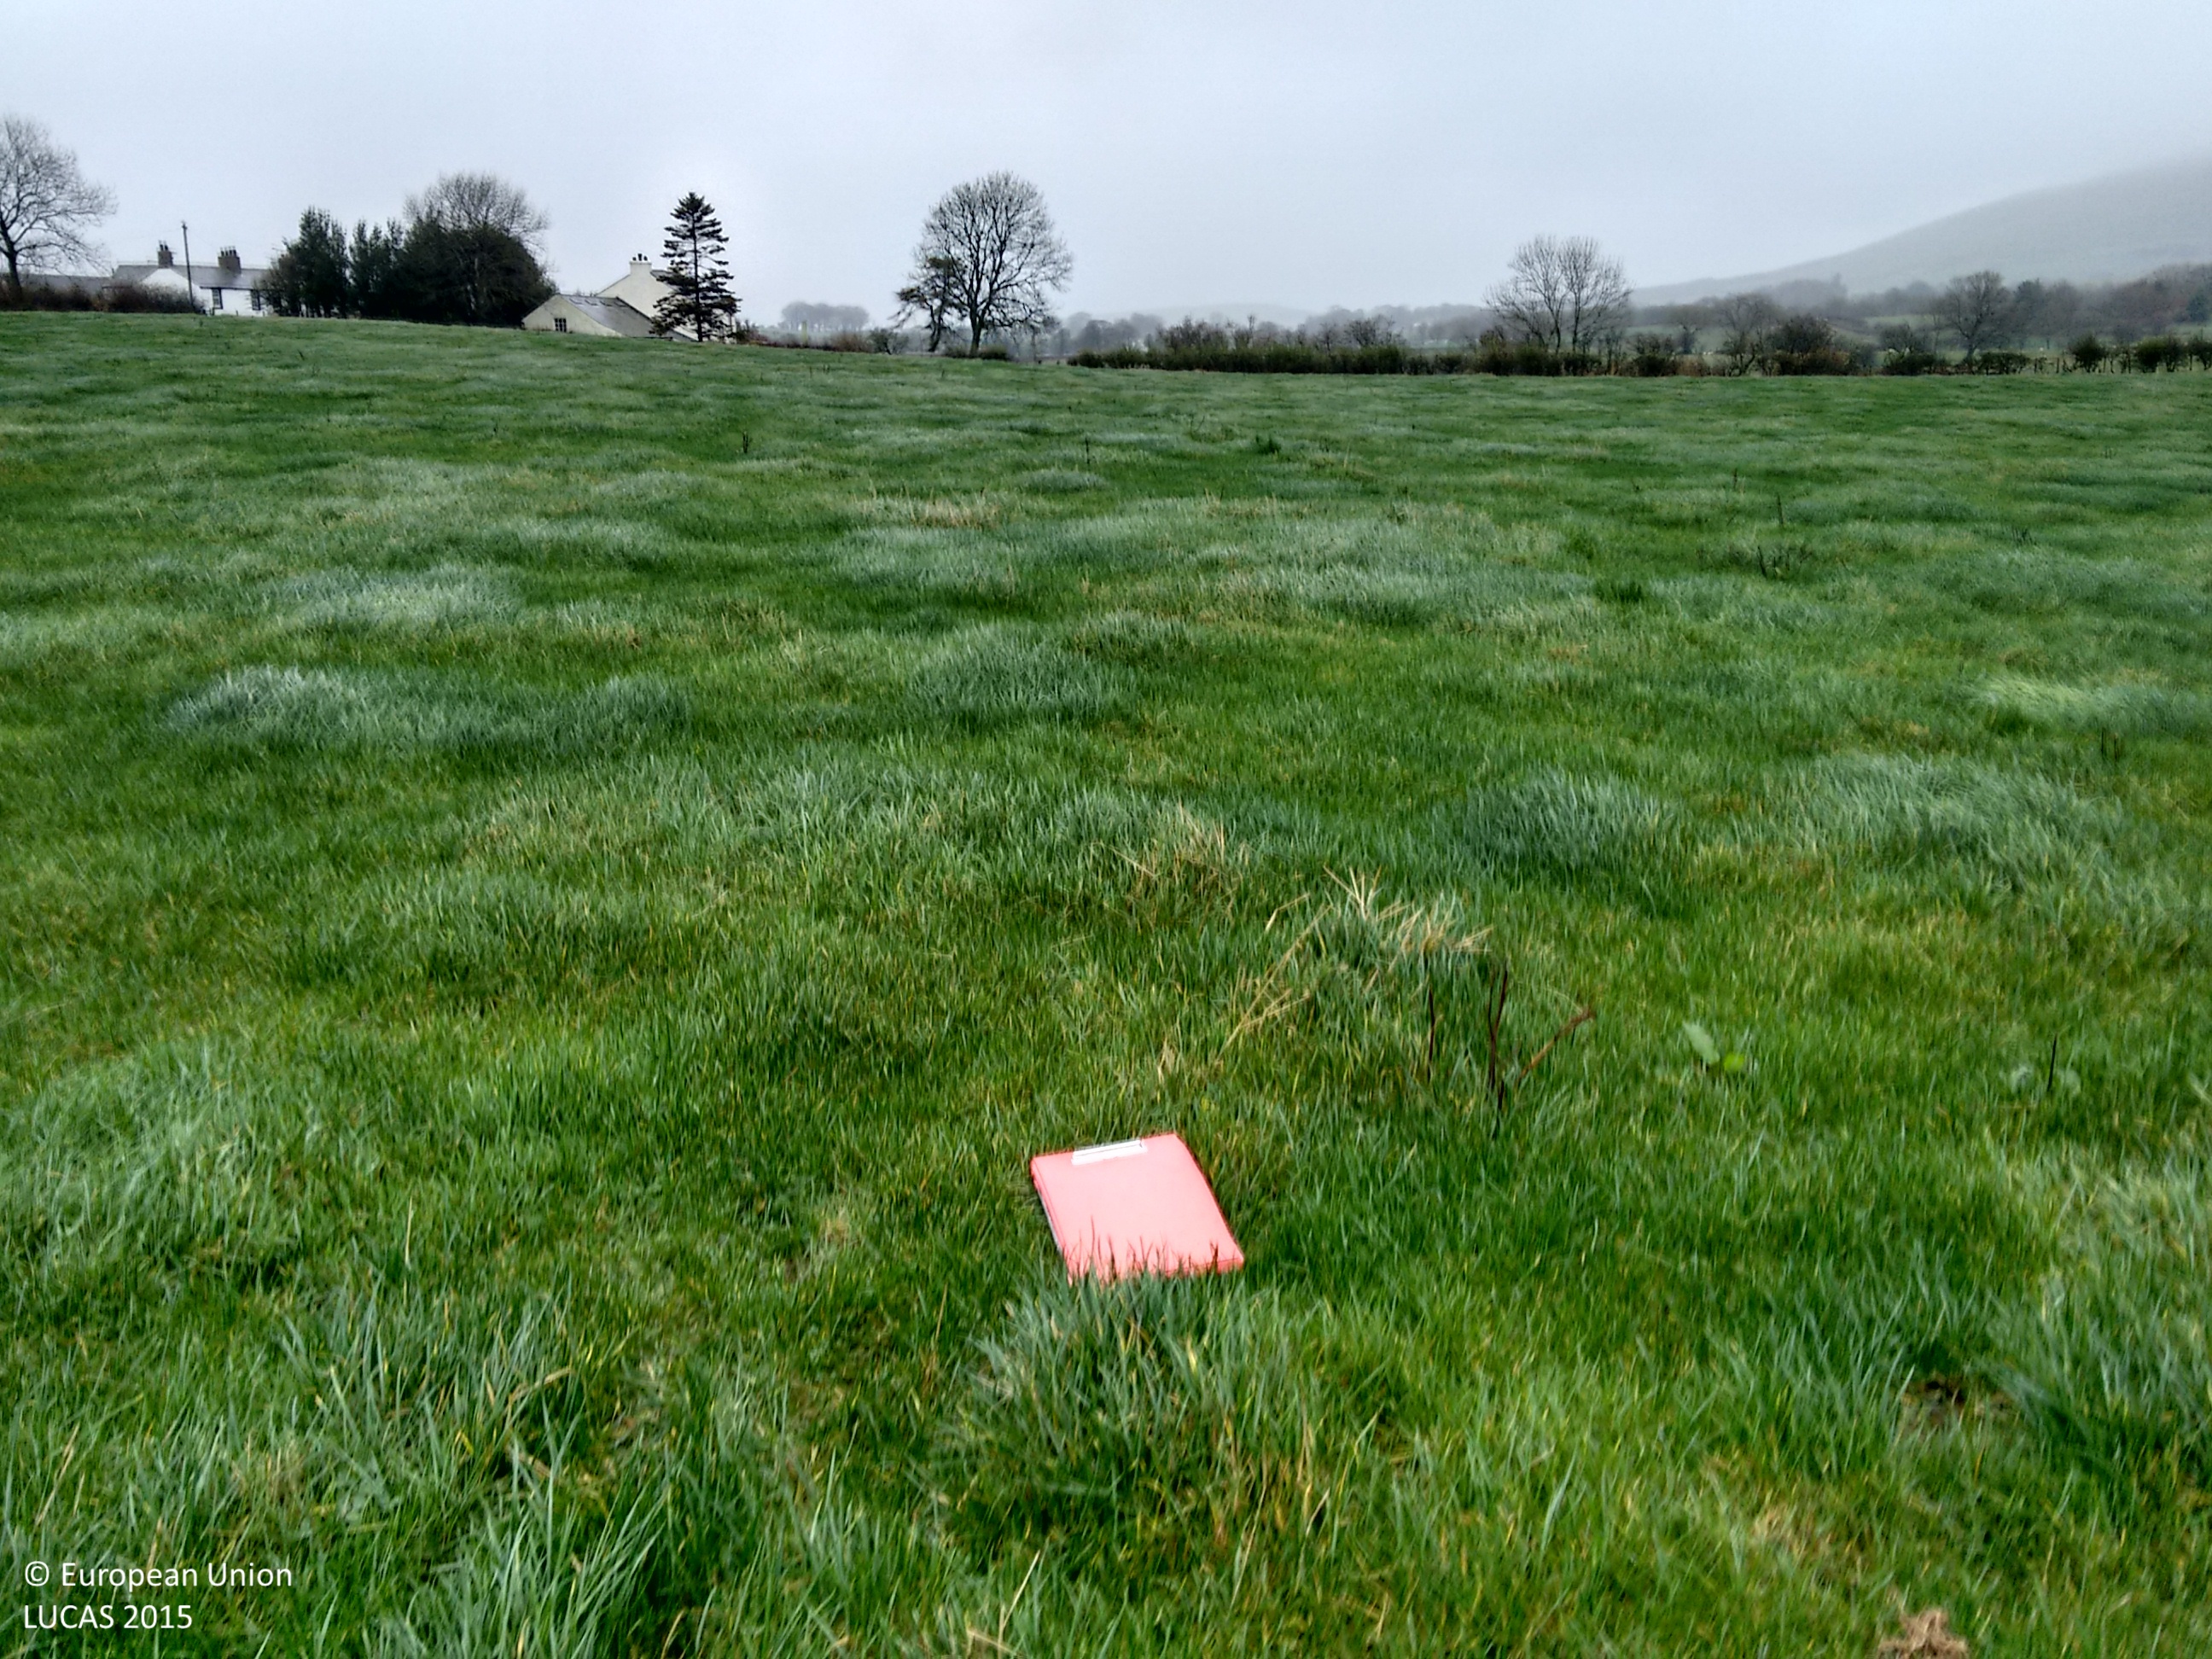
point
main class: Grassland
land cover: Grassland without tree/shrub cover
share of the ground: > 75 %
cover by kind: herbaceous plants 100 %
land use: Agriculture (excluding fallow land and kitchen gardens)
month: November
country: GB
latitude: 54.5651
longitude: -3.4275
